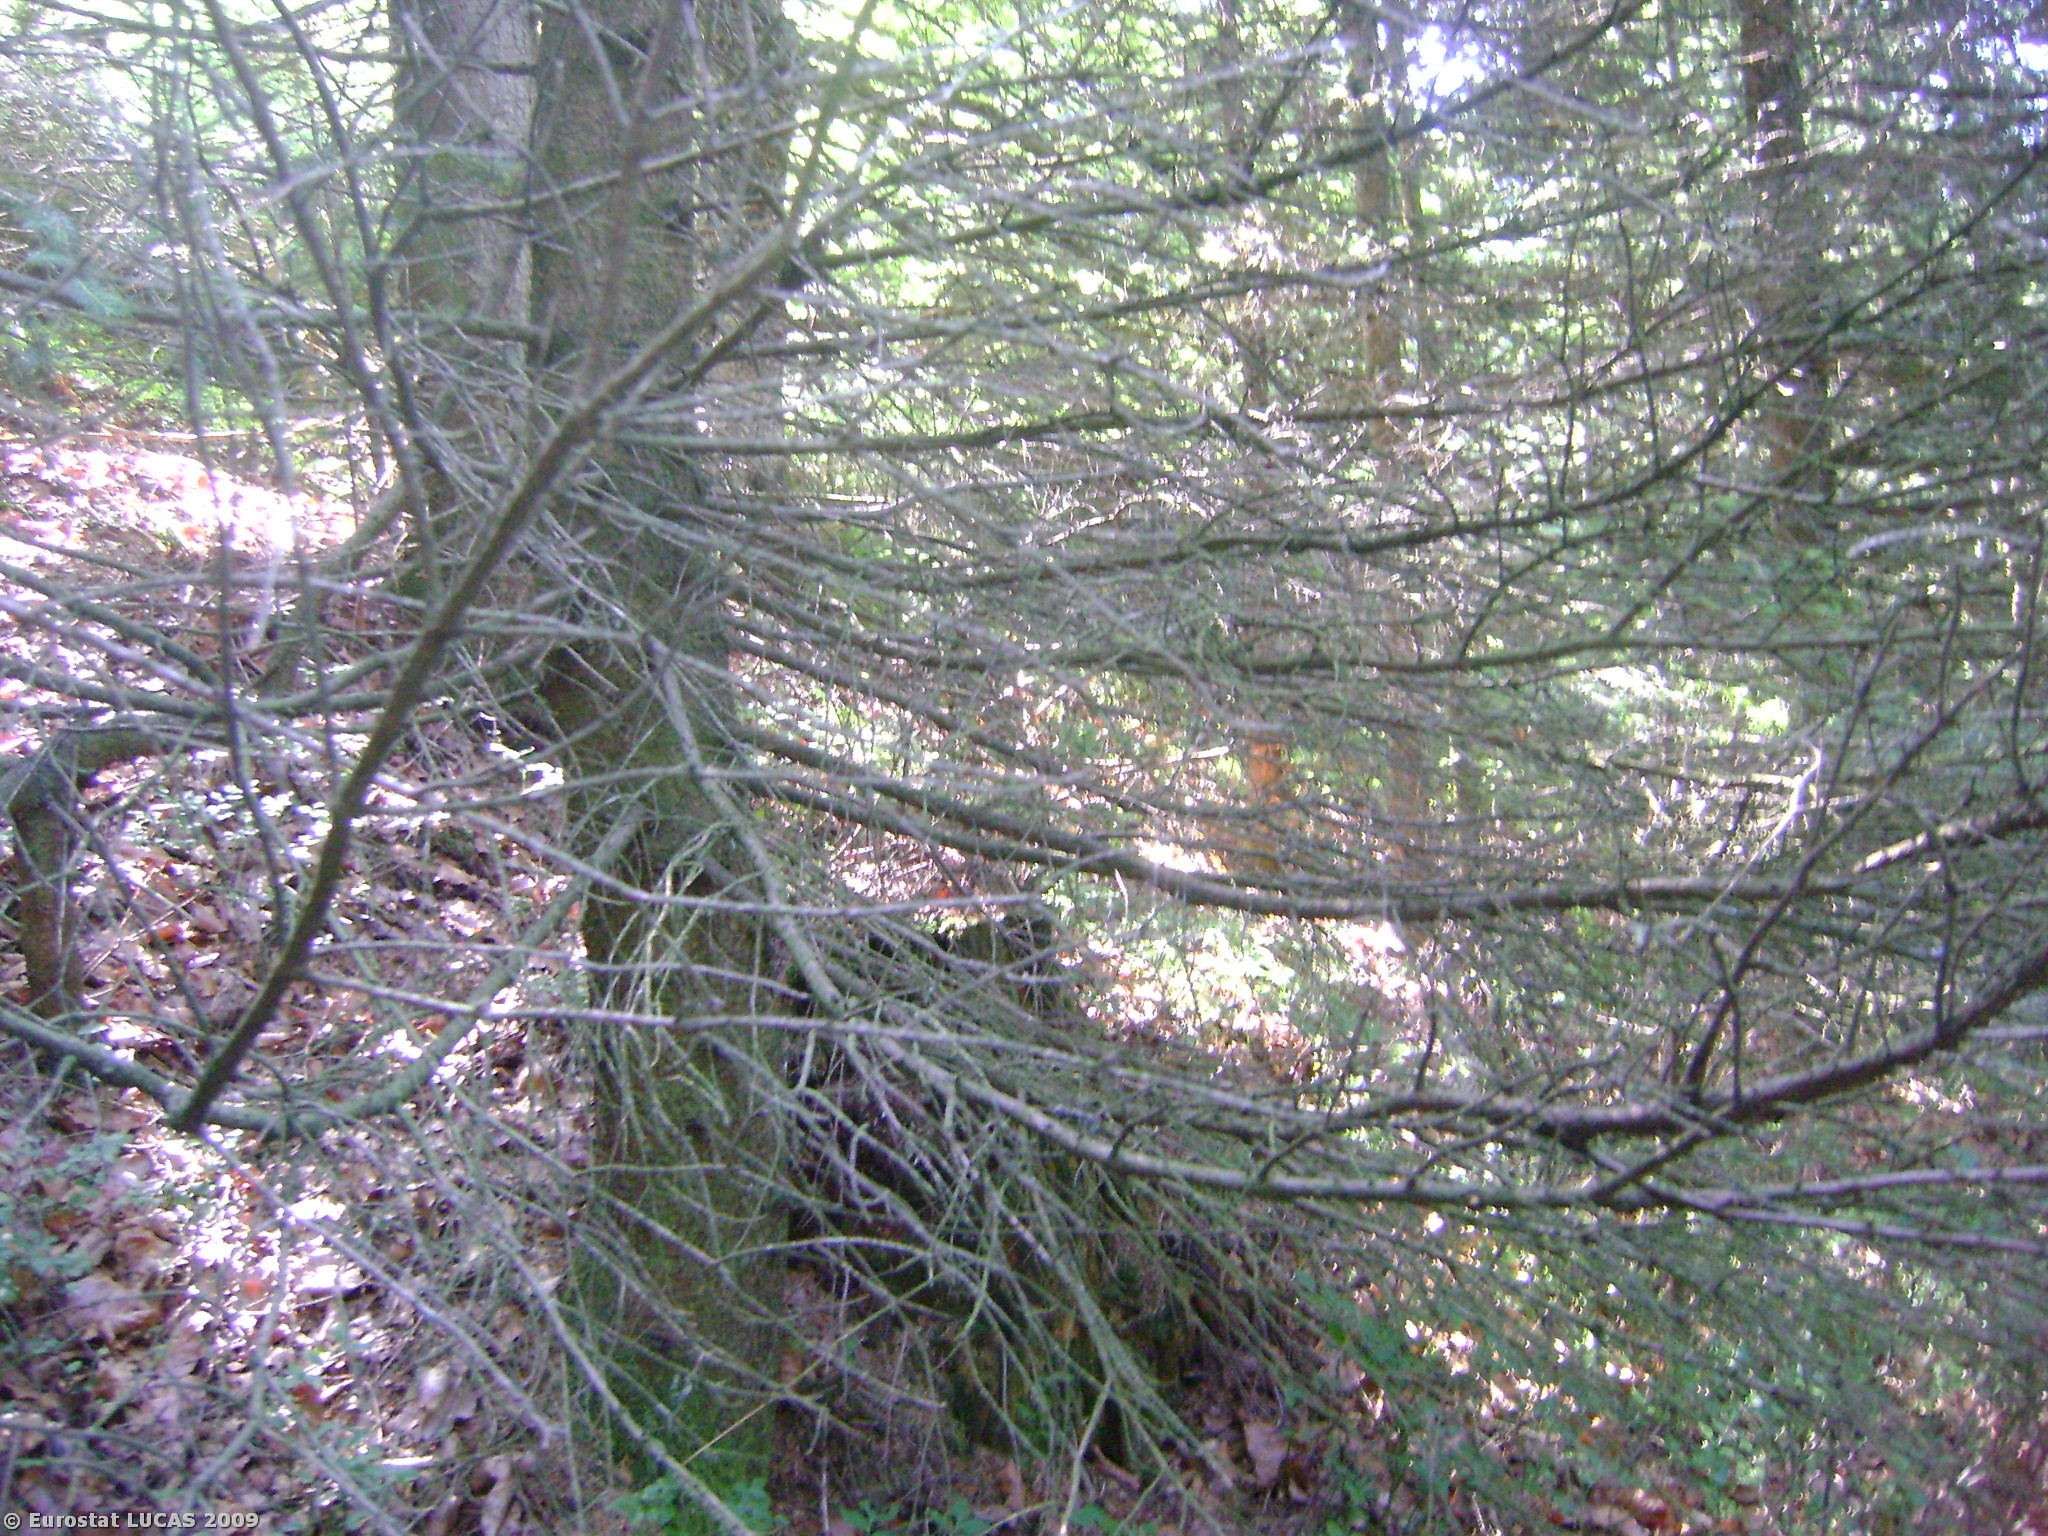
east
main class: Woodland
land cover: Coniferous woodland
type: hemiboreal forest and nemoral coniferous forest and mixed broadleaved-coniferous forest
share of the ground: > 75 %
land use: Forestry
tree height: > 5 m
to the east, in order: Coniferous woodland; Tracks; Coniferous woodland
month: June
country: AT
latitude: 48.0314
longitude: 13.2577
